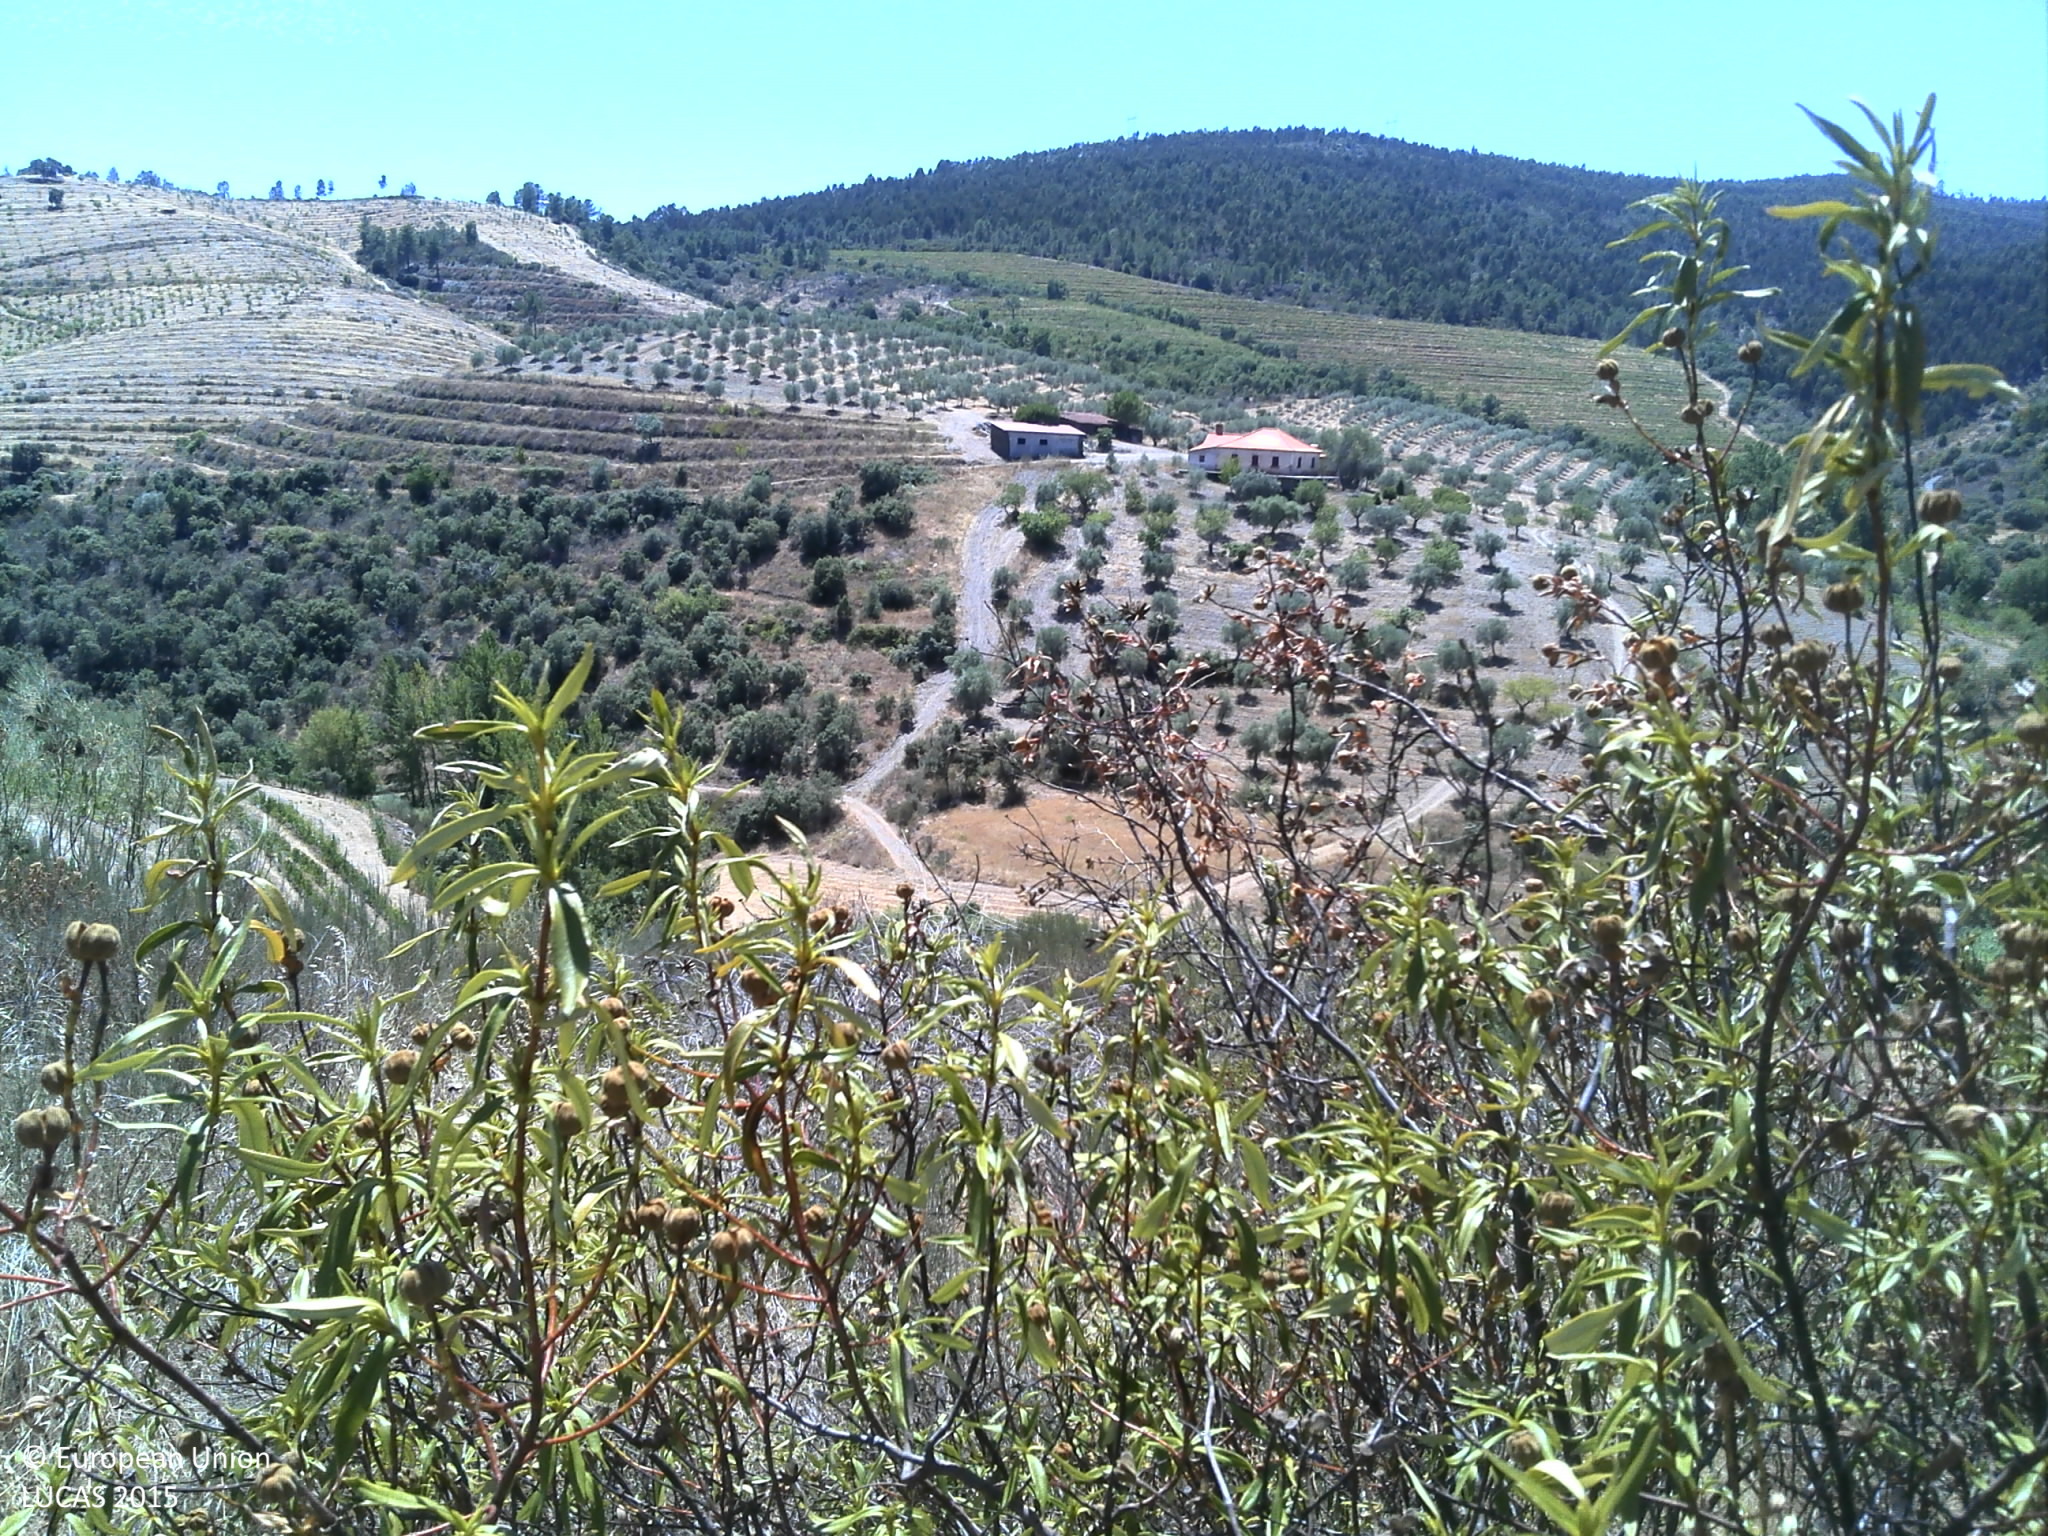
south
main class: Shrubland
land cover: Shrubland without tree cover
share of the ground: > 75 %
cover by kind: shrubs 80 %, herbaceous plants 20 %
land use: Abandoned areas
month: July
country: PT
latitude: 41.3138
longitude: -7.1127
